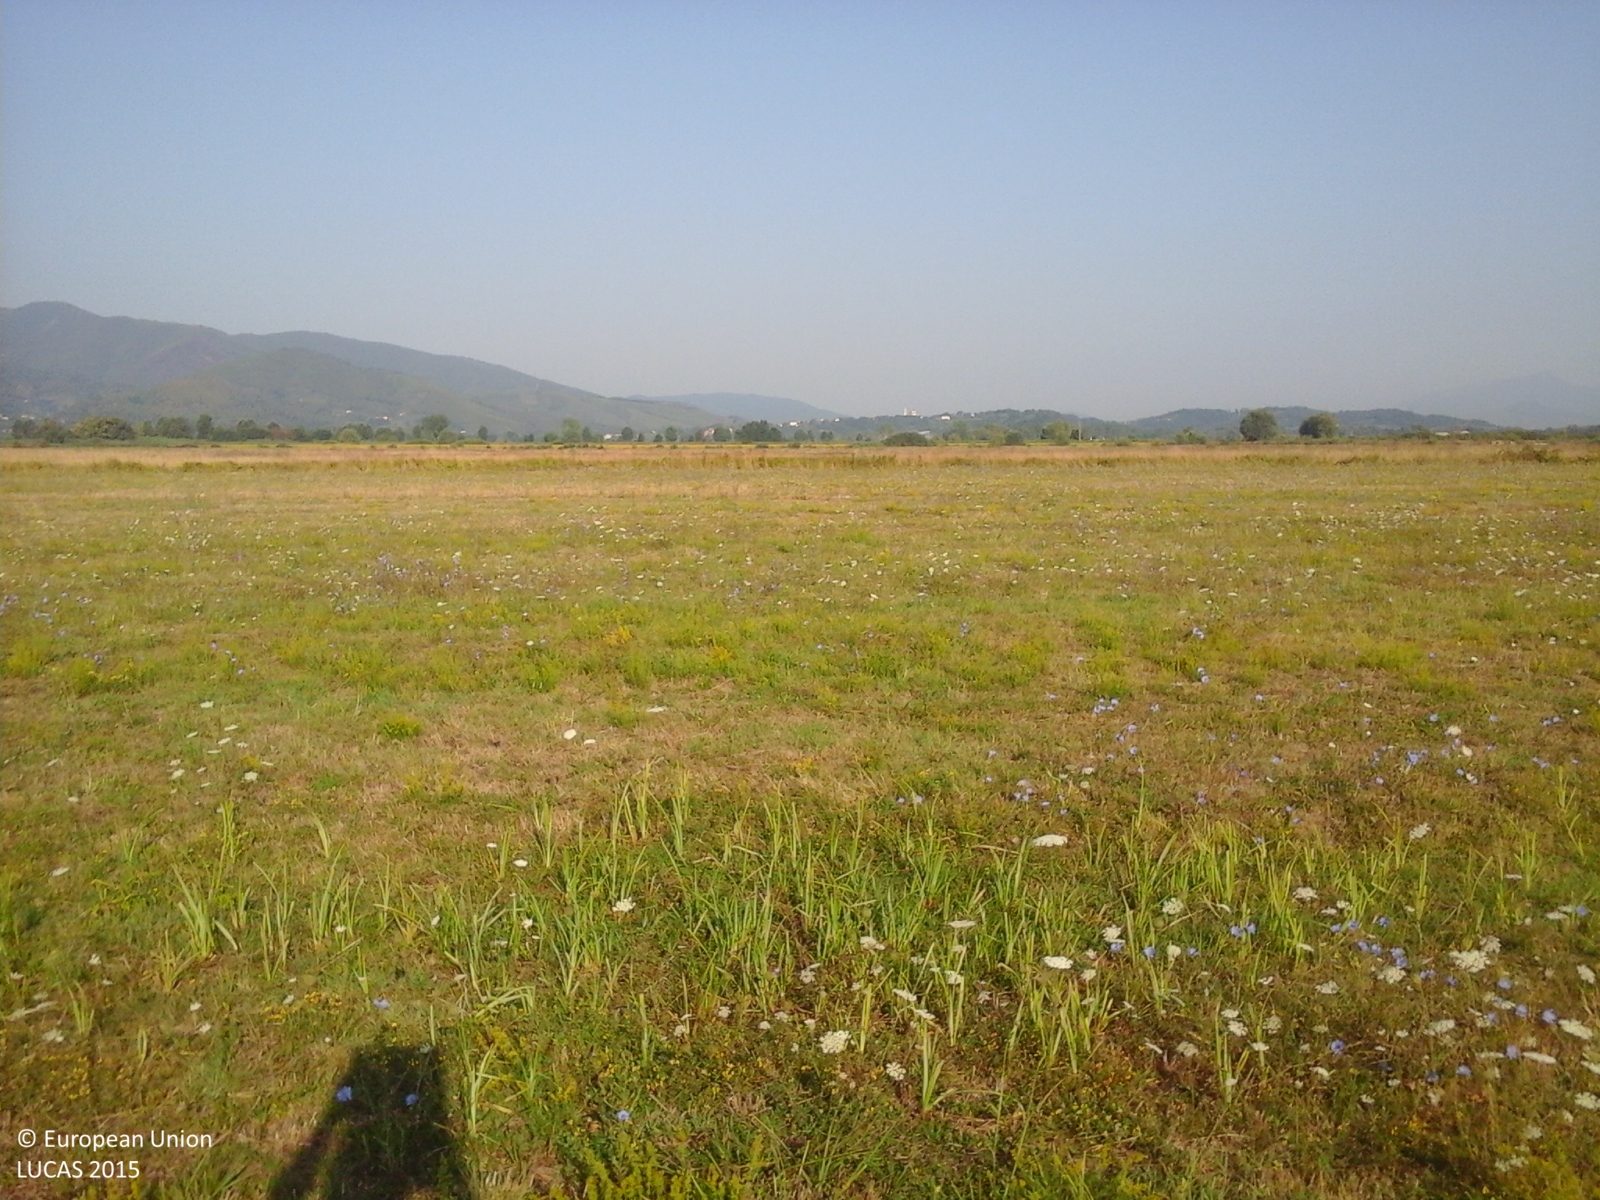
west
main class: Cropland
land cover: Temporary grasslands
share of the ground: > 75 %
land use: Agriculture (excluding fallow land and kitchen gardens)
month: August
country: IT
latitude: 43.7894
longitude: 10.6321
